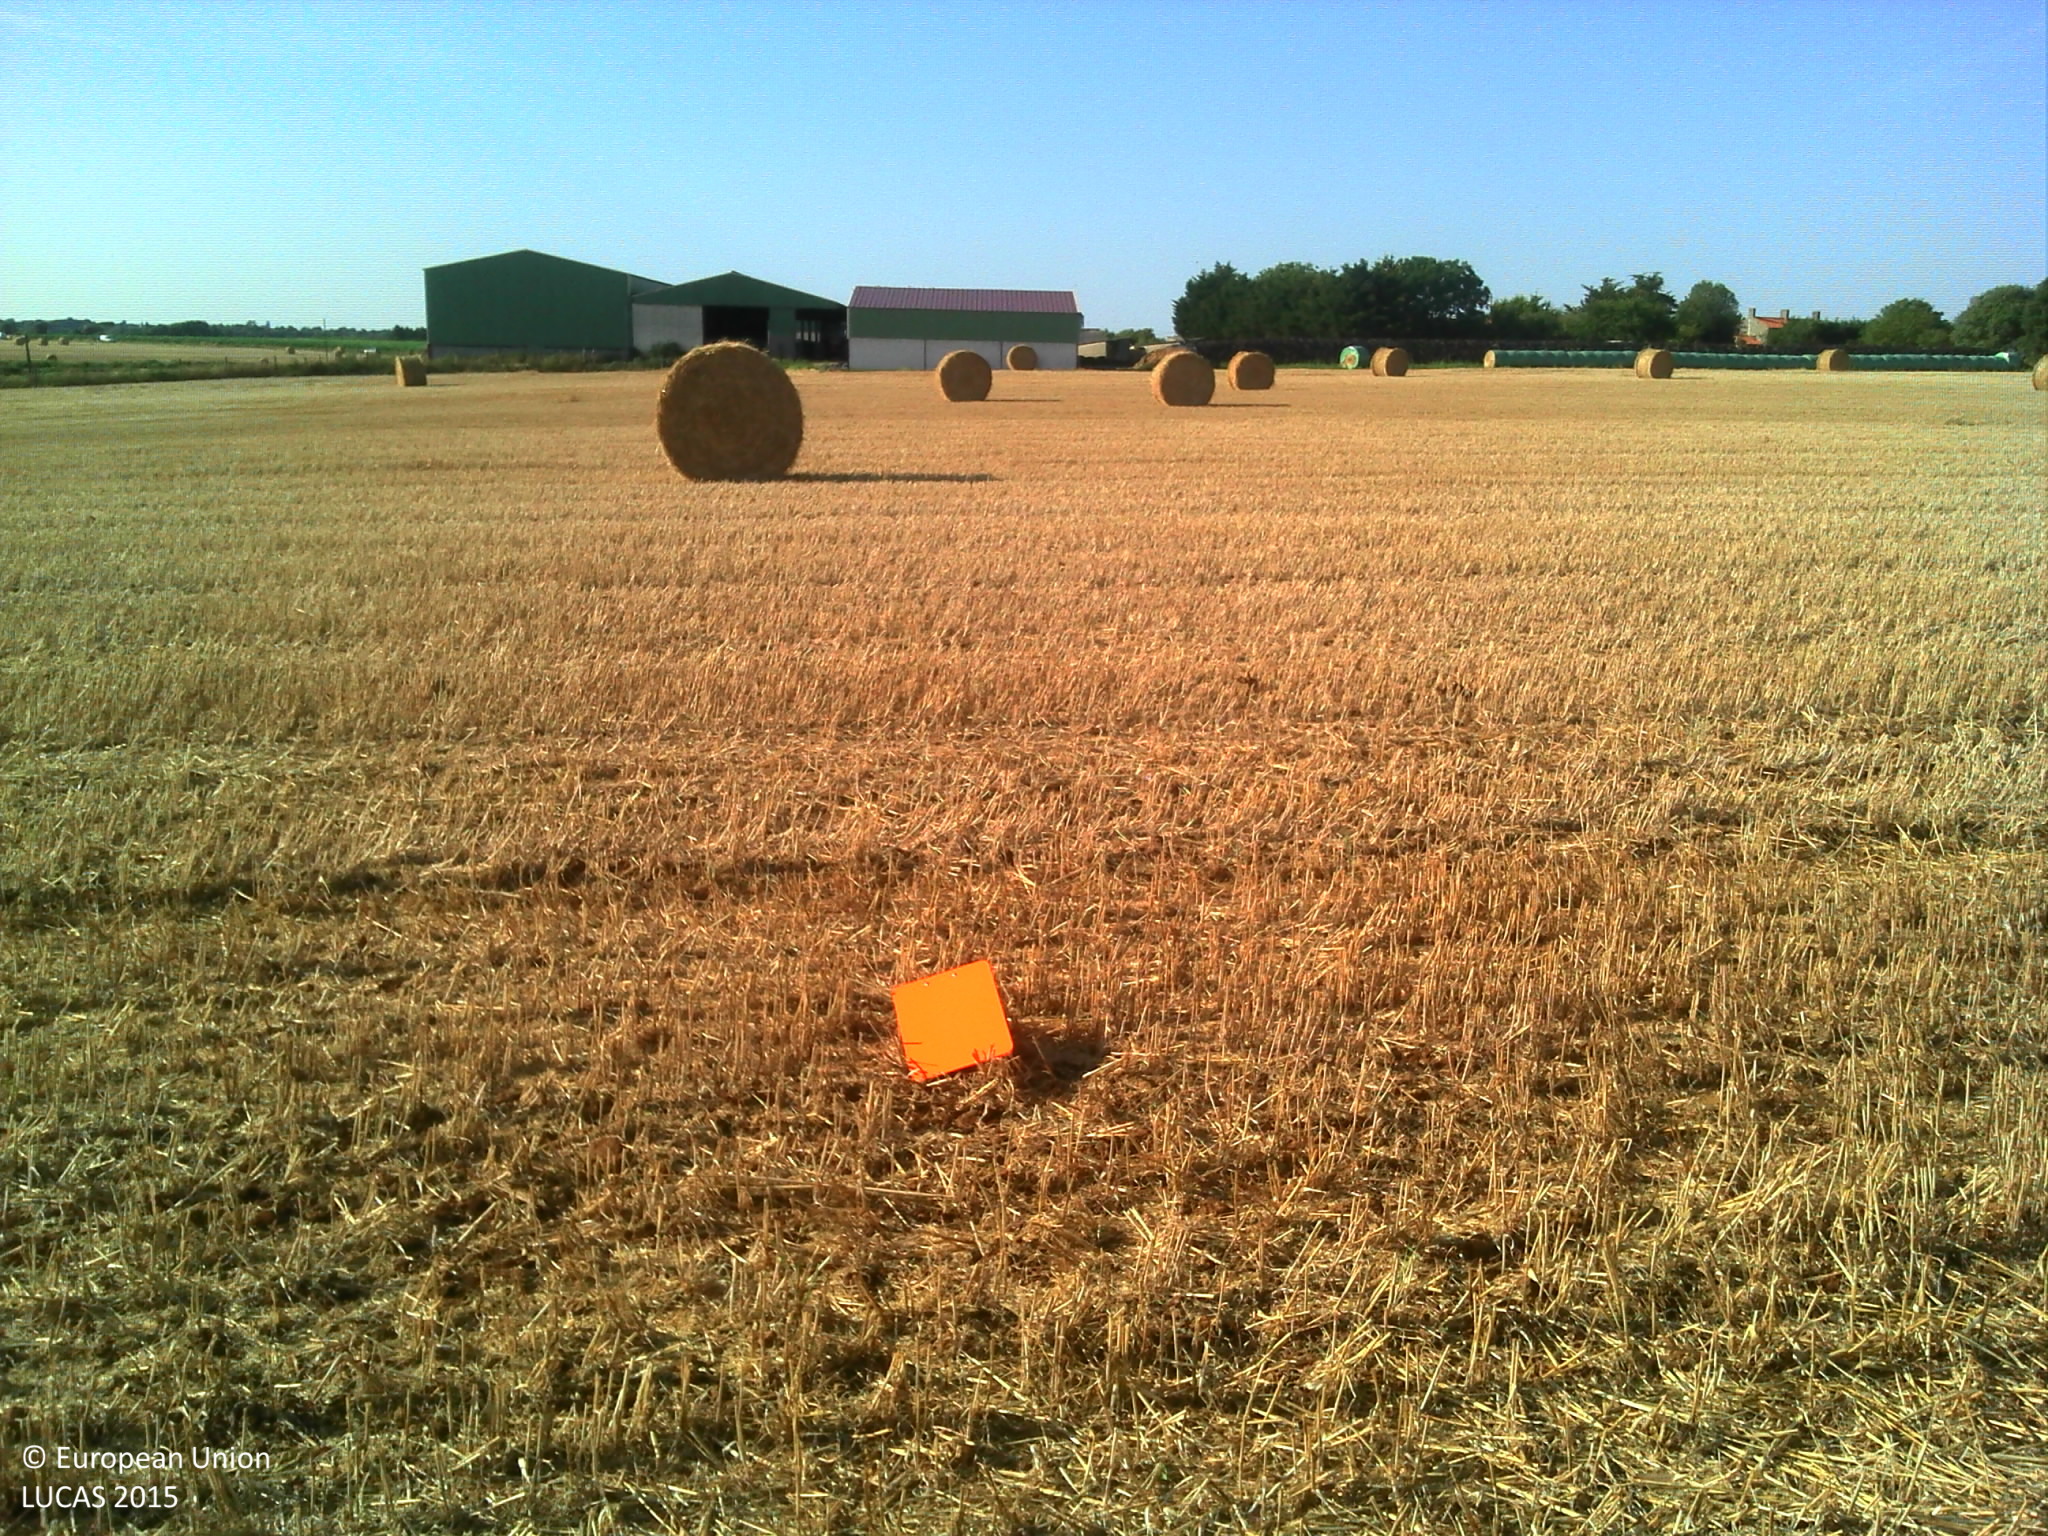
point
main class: Cropland
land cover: Common wheat
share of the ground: > 75 %
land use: Agriculture (excluding fallow land and kitchen gardens)
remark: Harvested field
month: July
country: FR
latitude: 46.4469
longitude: -1.5852
